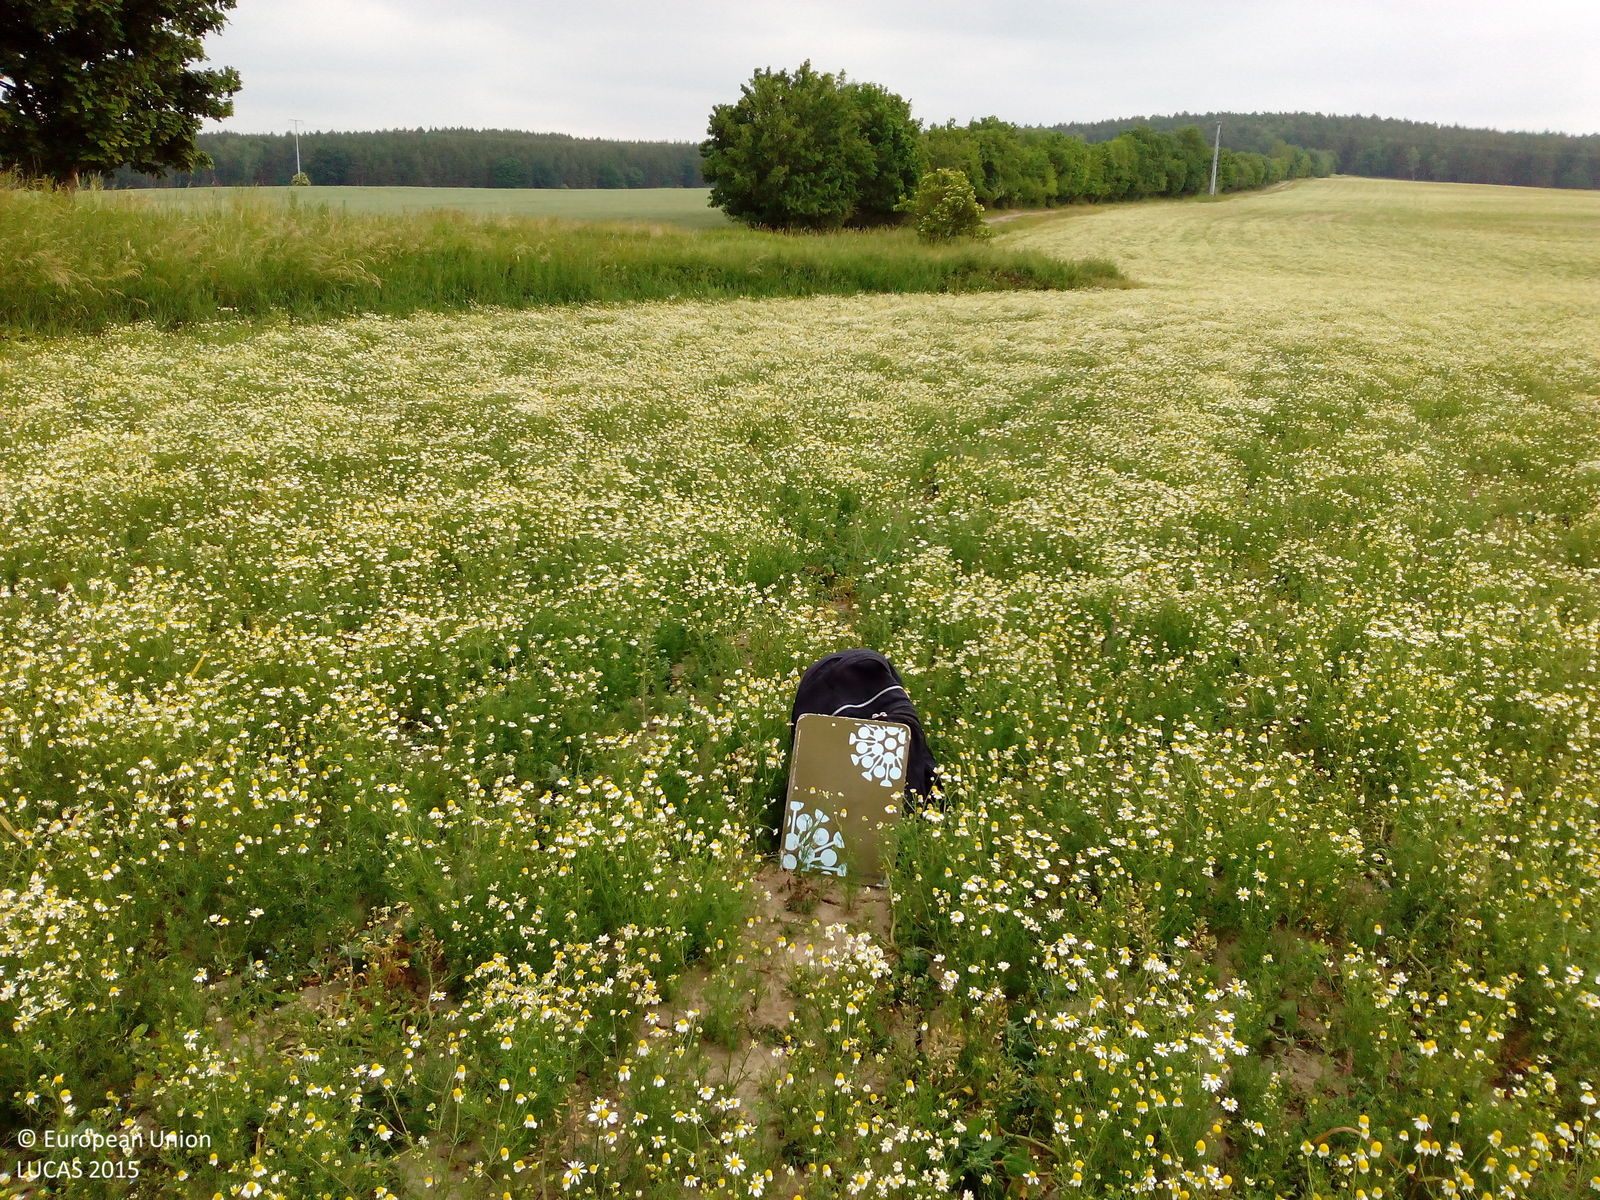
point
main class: Grassland
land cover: Spontaneously vegetated surfaces
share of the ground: > 75 %
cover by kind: herbaceous plants 80 %, unconsolidated bare surface 20 %
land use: Fallow land
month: June
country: DE
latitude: 50.7133
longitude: 11.5433
